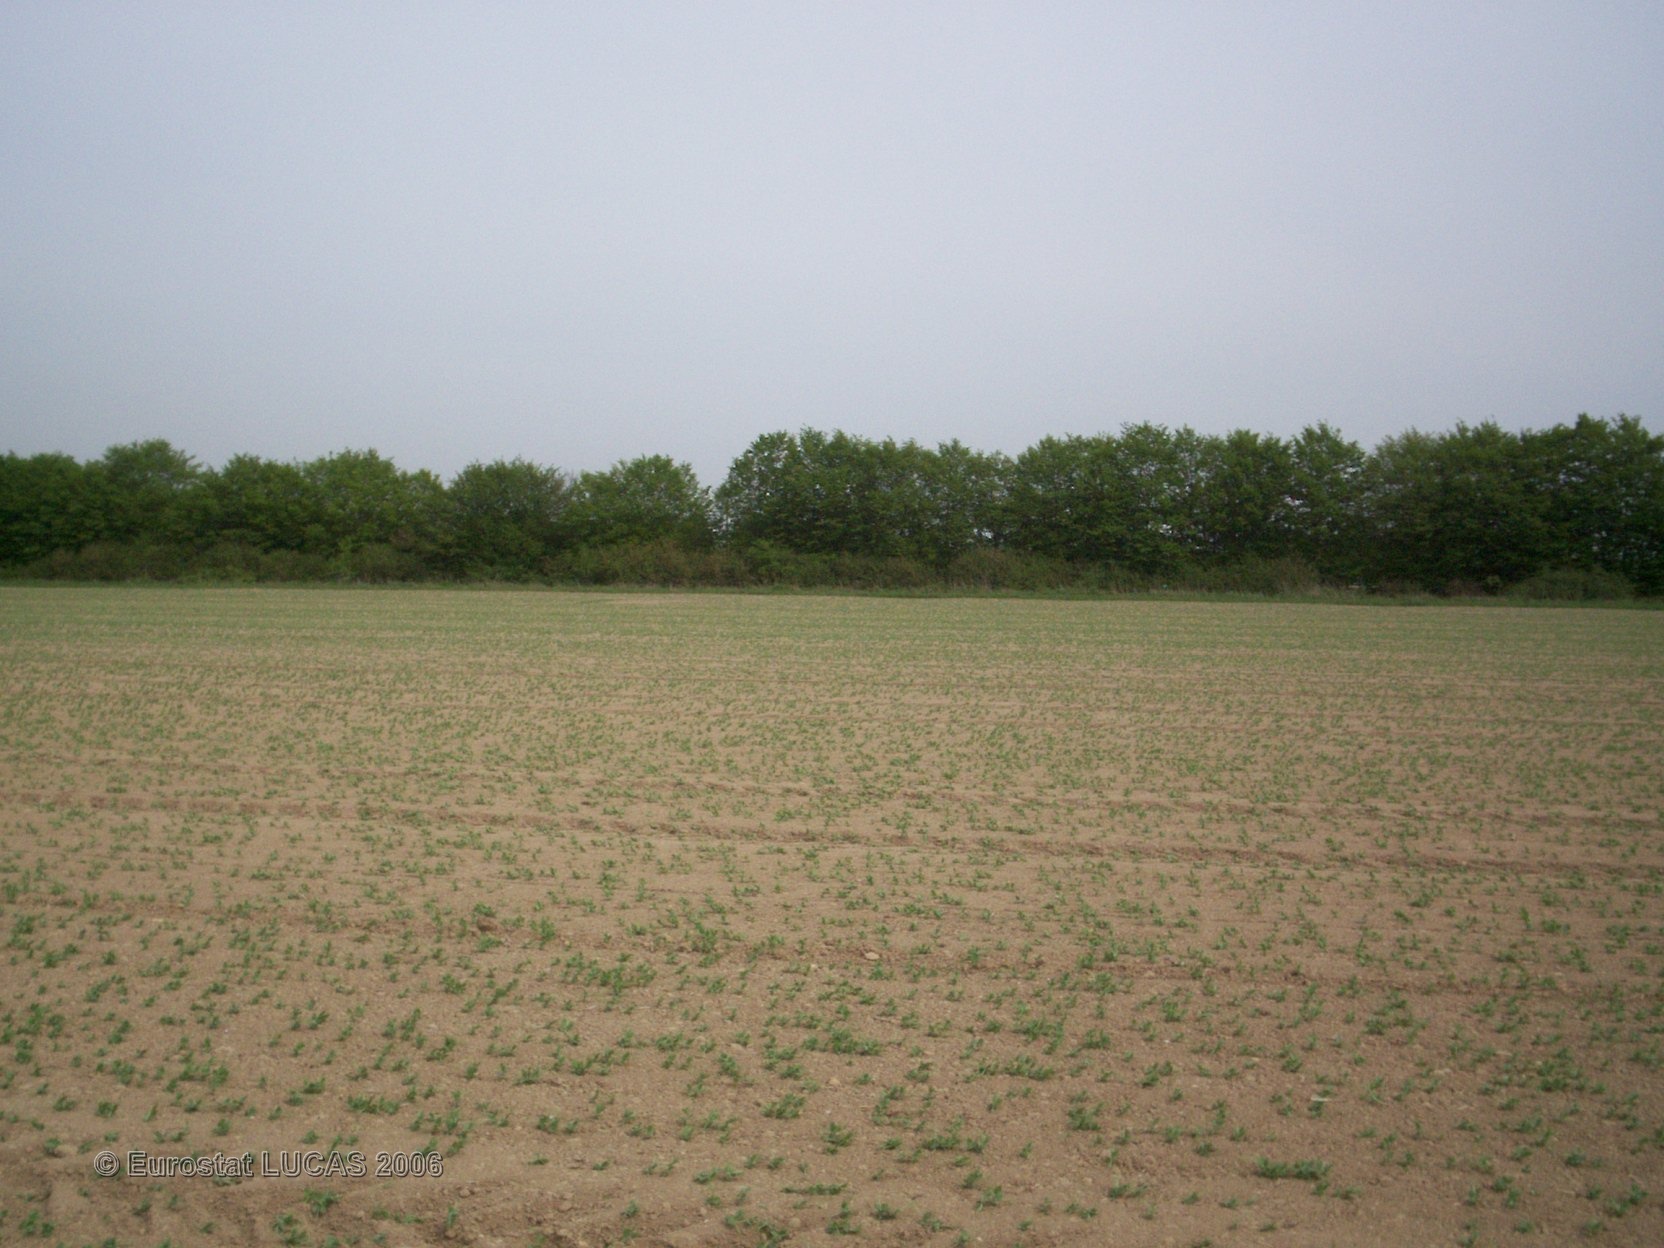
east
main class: Cropland
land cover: Dry pulses
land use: Agriculture (excluding fallow land and kitchen gardens)
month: May
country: FR
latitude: 48.7337
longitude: 2.8800
